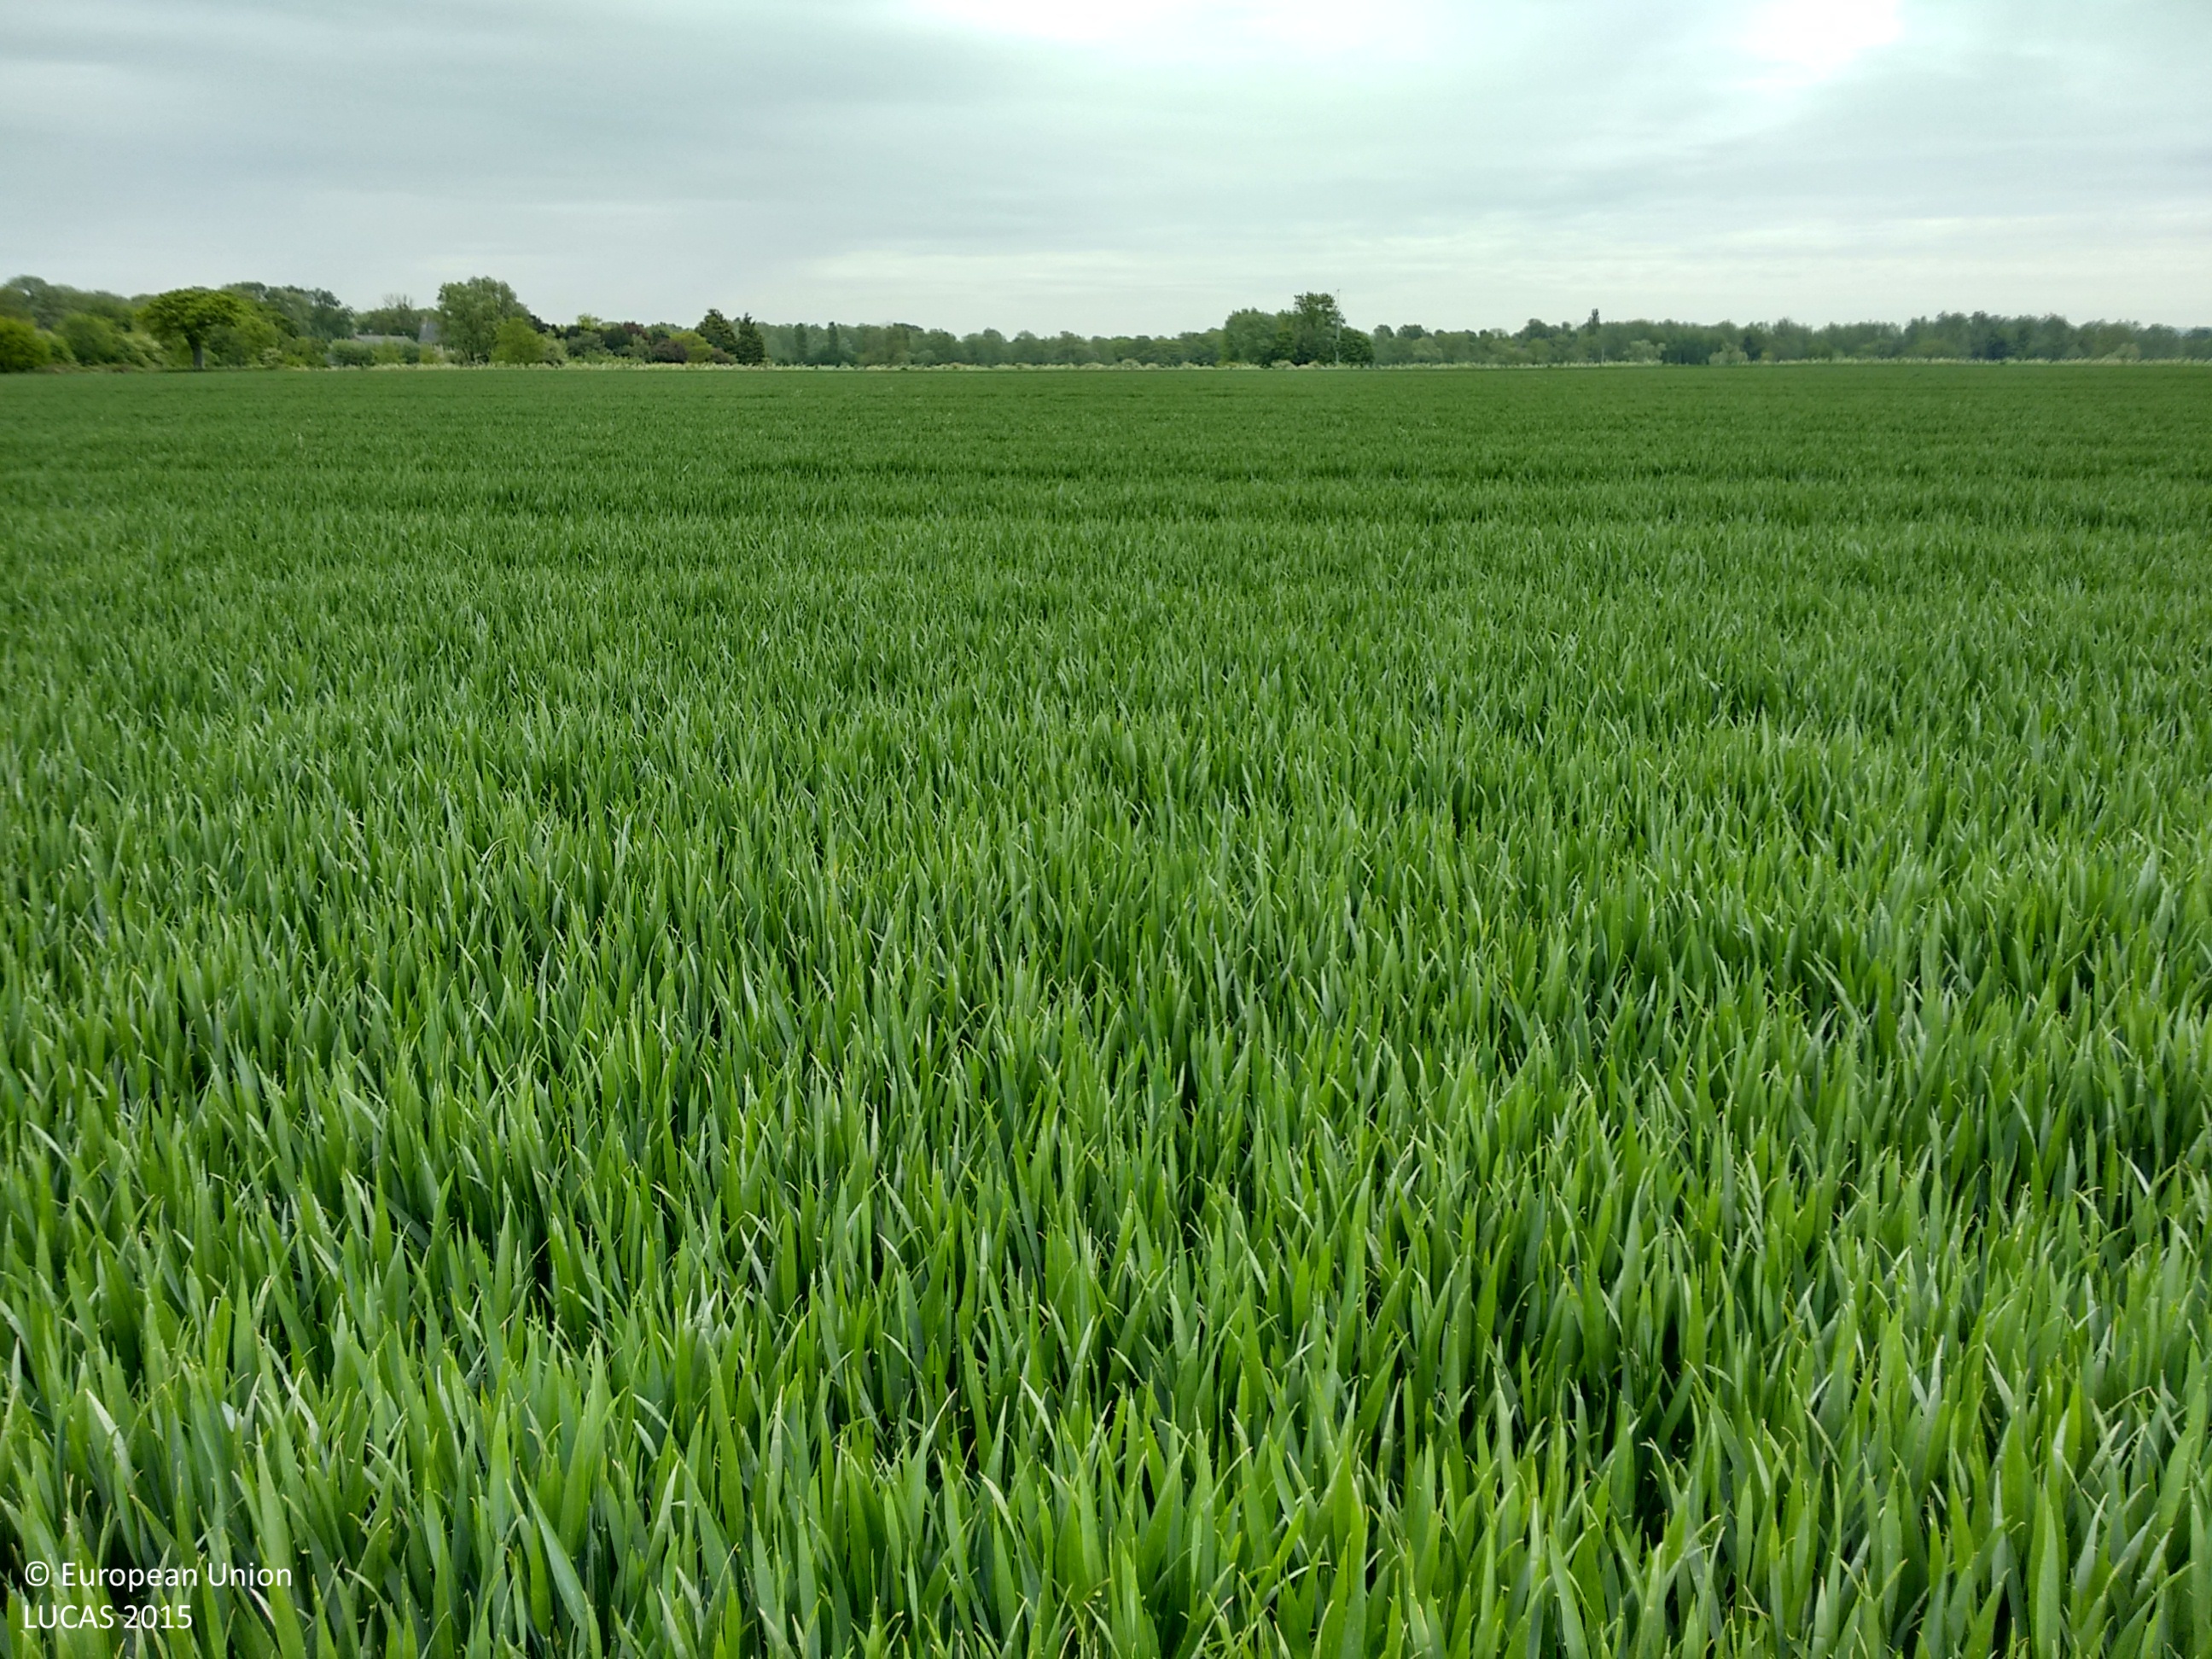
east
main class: Cropland
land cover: Barley
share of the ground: > 75 %
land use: Agriculture (excluding fallow land and kitchen gardens)
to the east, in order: Barley; Grass margins; Tracks; Grass margins; Common wheat
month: May
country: GB
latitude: 52.0206
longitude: -0.2803
